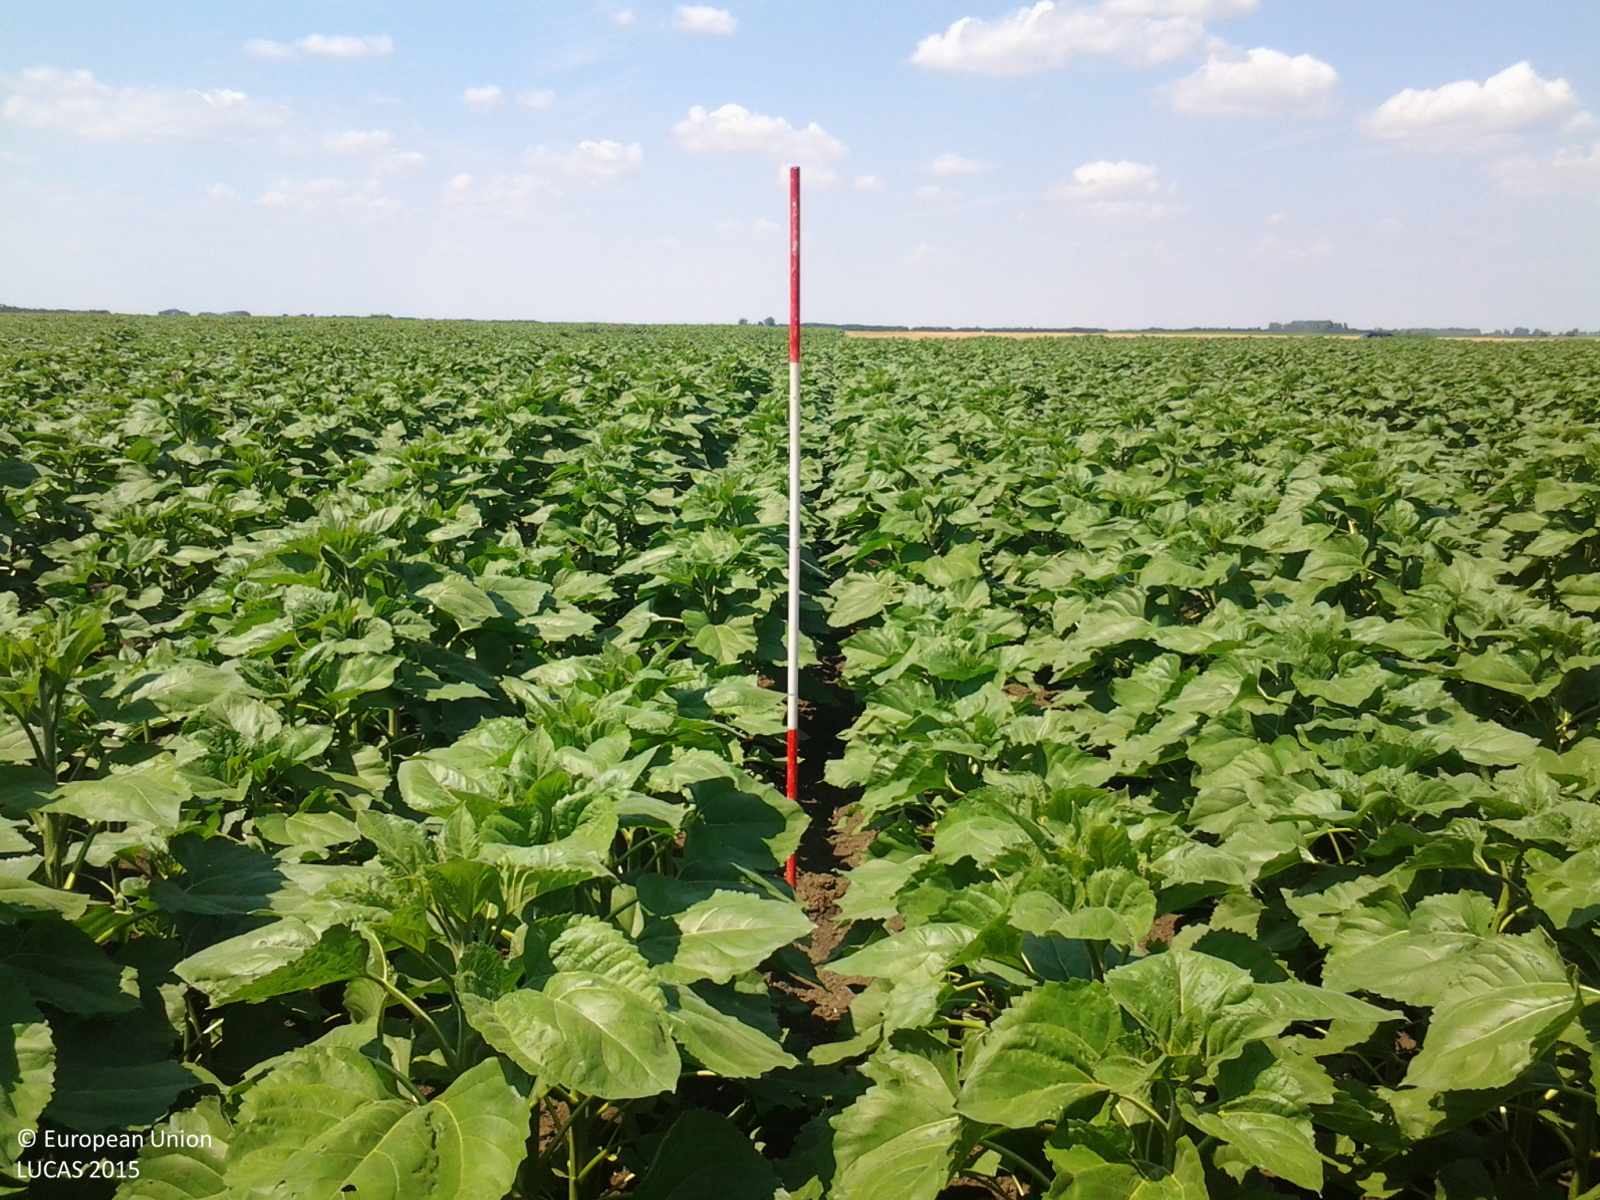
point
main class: Cropland
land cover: Sunflower
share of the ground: > 75 %
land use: Agriculture (excluding fallow land and kitchen gardens)
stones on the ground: < 10 %
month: July
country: HU
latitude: 46.9430
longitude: 20.4724
